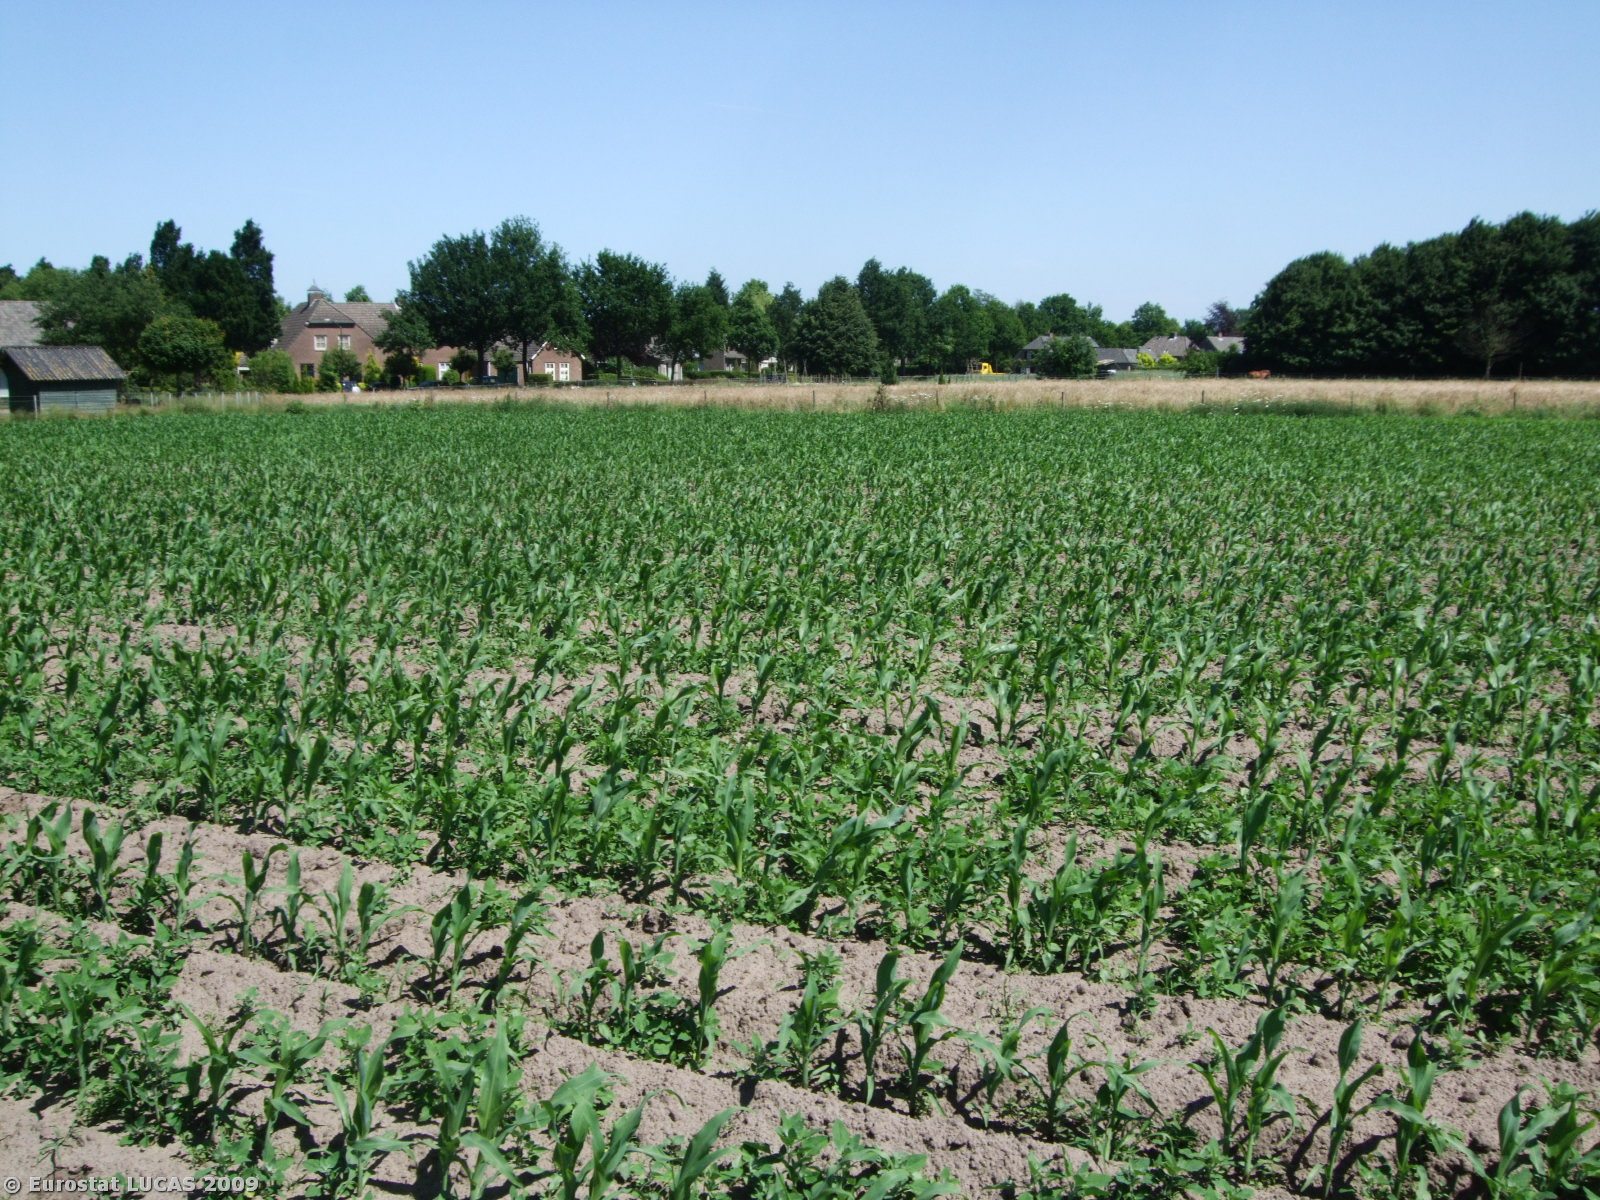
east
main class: Cropland
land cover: Maize
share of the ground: 25 - 50 %
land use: Agriculture (excluding fallow land and kitchen gardens)
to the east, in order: Maize; Fences; Grassland without tree/shrub cover; Fences; Artificial constructions in urban areas; Fences; Grassland without tree/shrub cover; Fences; Grassland with sparse tree/shrub cover; Artificial constructions in urban areas; Ditches and canals; Lines of trees; Paved roads, cycling and walking lanes; Artificial constructions in urban areas
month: June
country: NL
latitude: 51.5669
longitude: 5.3670
